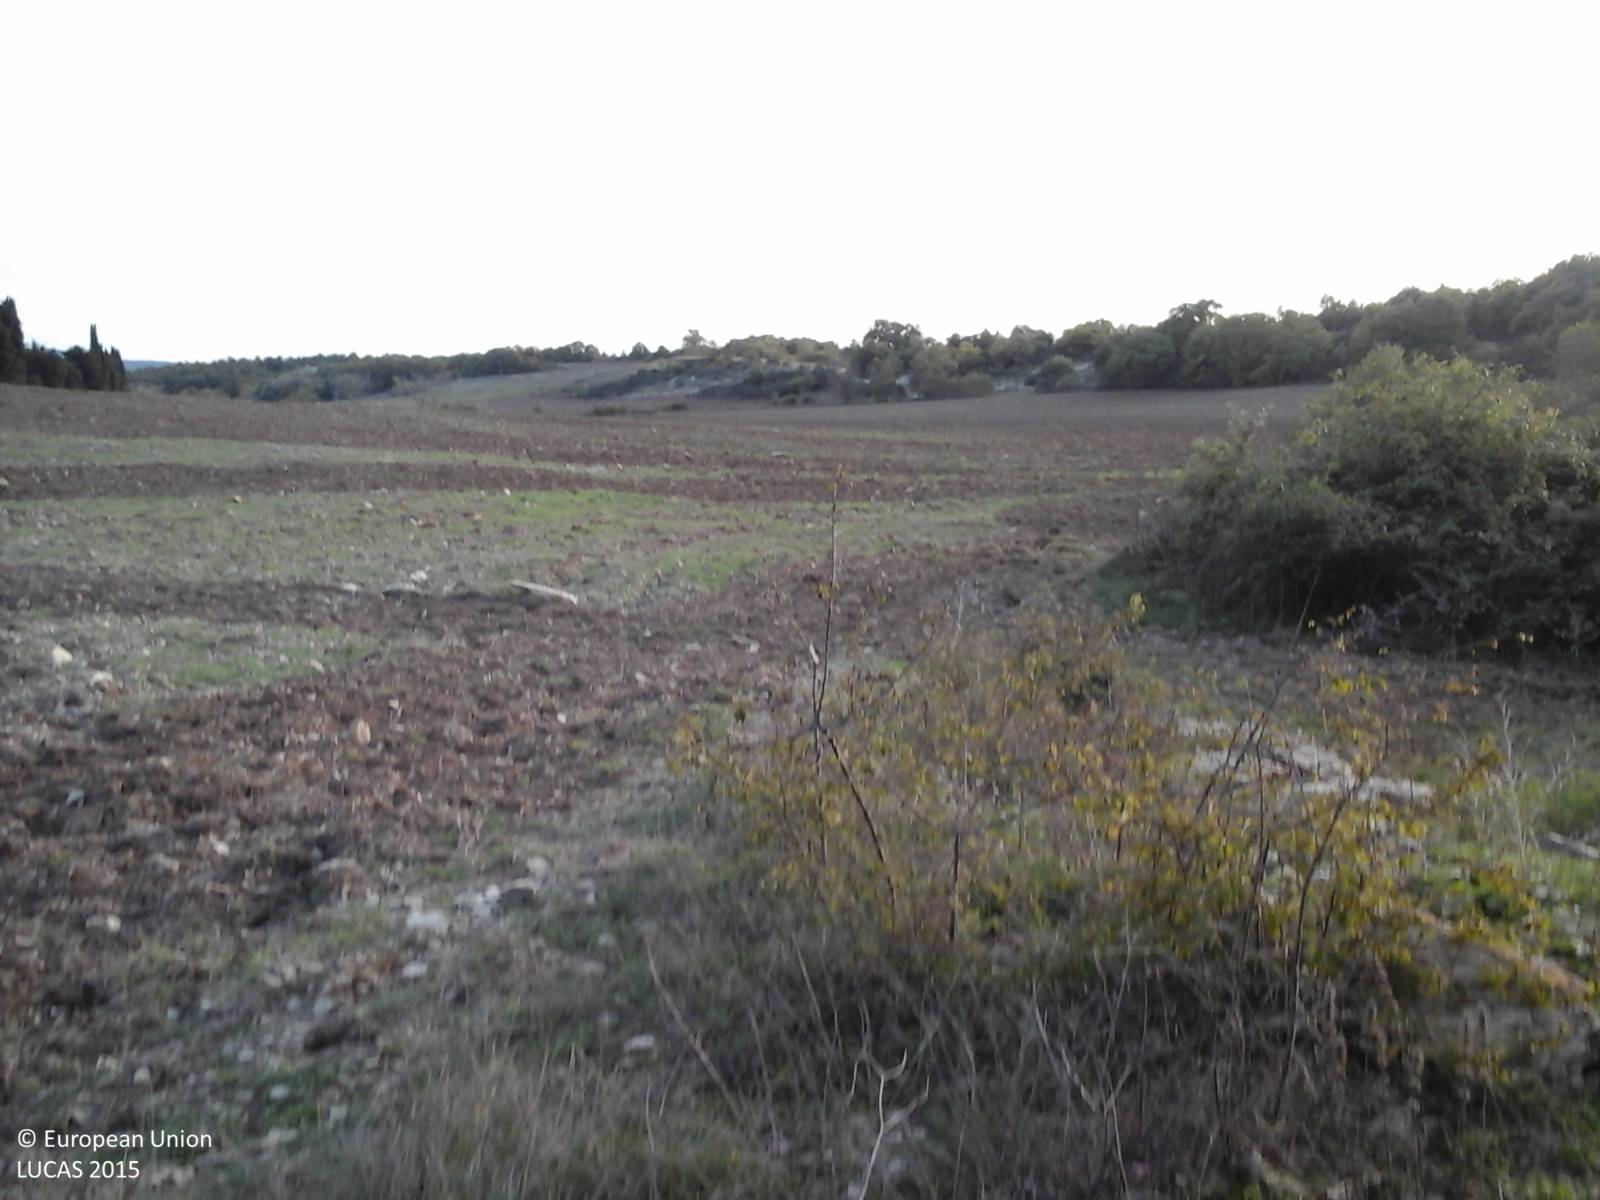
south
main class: Woodland
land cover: Broadleaved woodland
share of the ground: > 75 %
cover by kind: broadleaved forest trees 70 %, shrubs 30 %
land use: Agriculture (excluding fallow land and kitchen gardens)
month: October
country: IT
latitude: 42.7729
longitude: 12.2783
